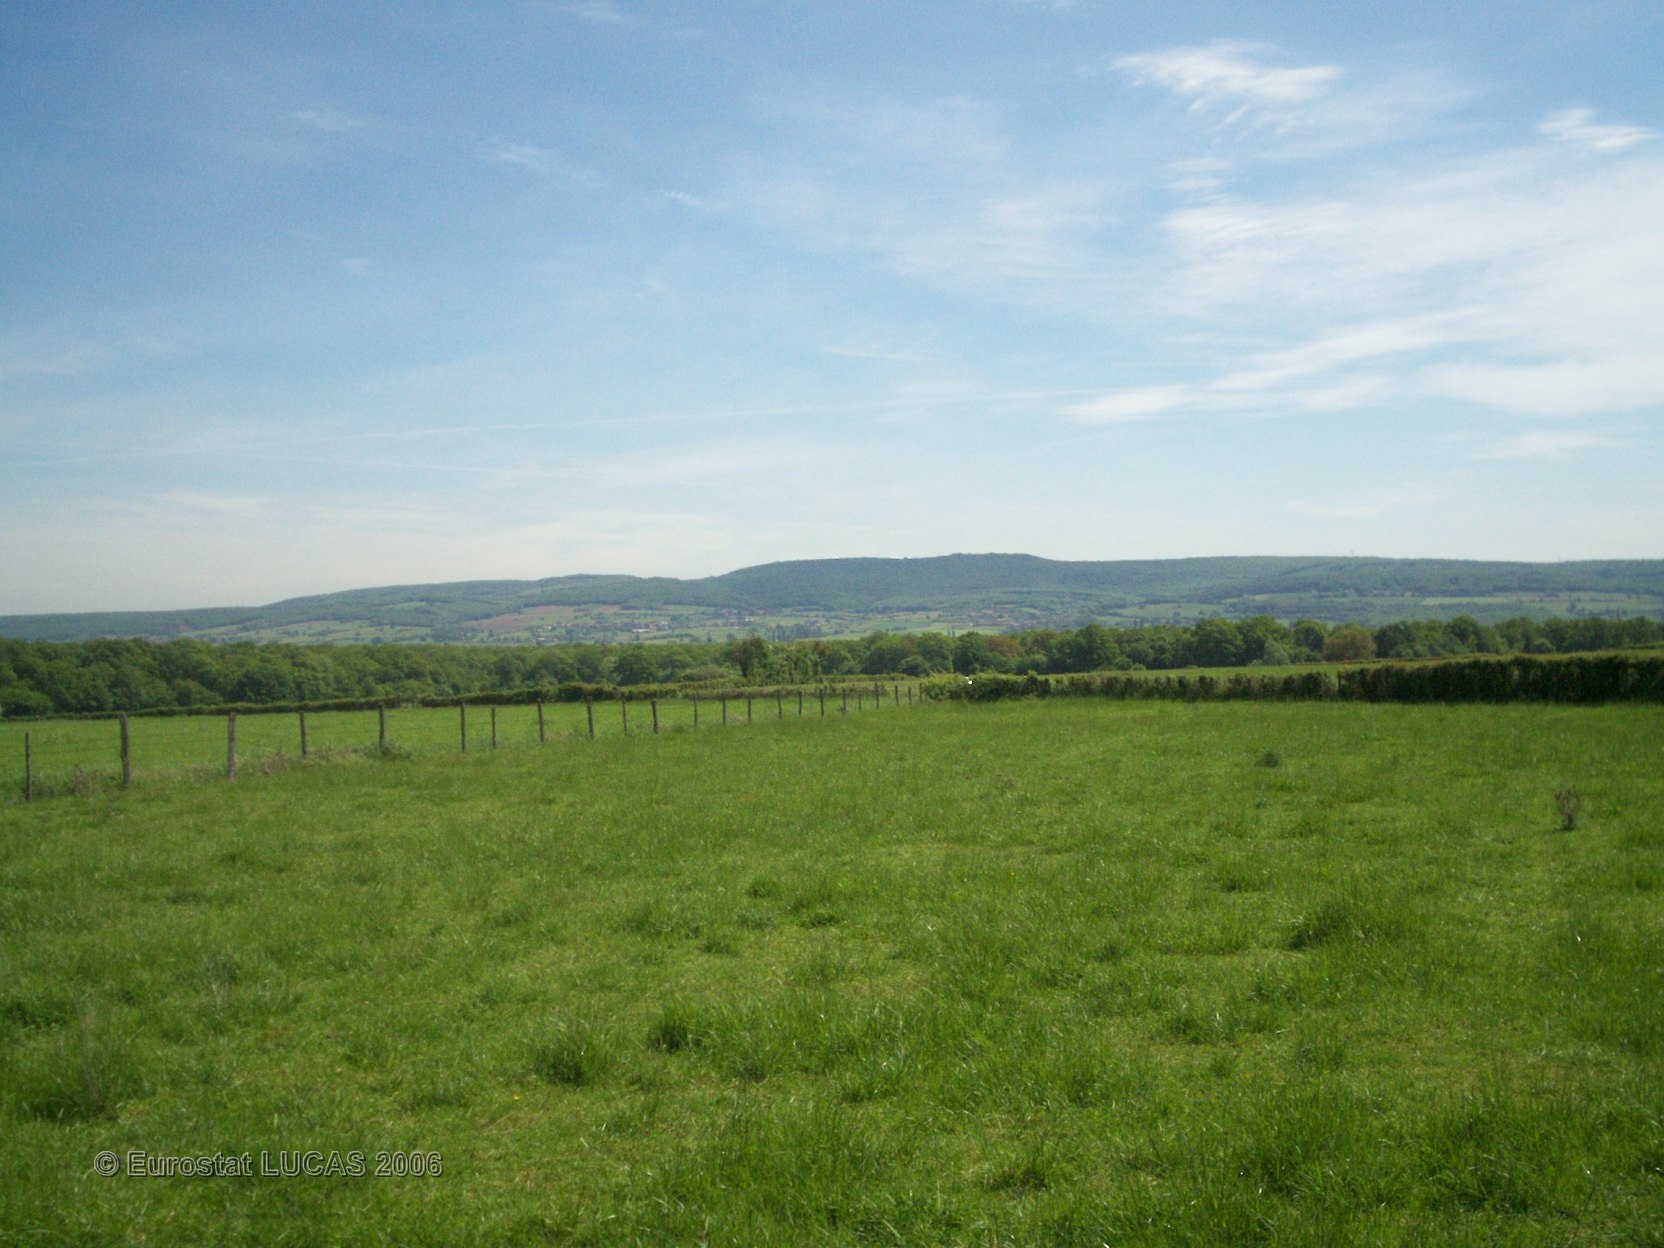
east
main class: Grassland
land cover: Grassland without tree/shrub cover
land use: Agriculture (excluding fallow land and kitchen gardens)
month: May
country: FR
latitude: 46.5829
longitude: 4.7424
